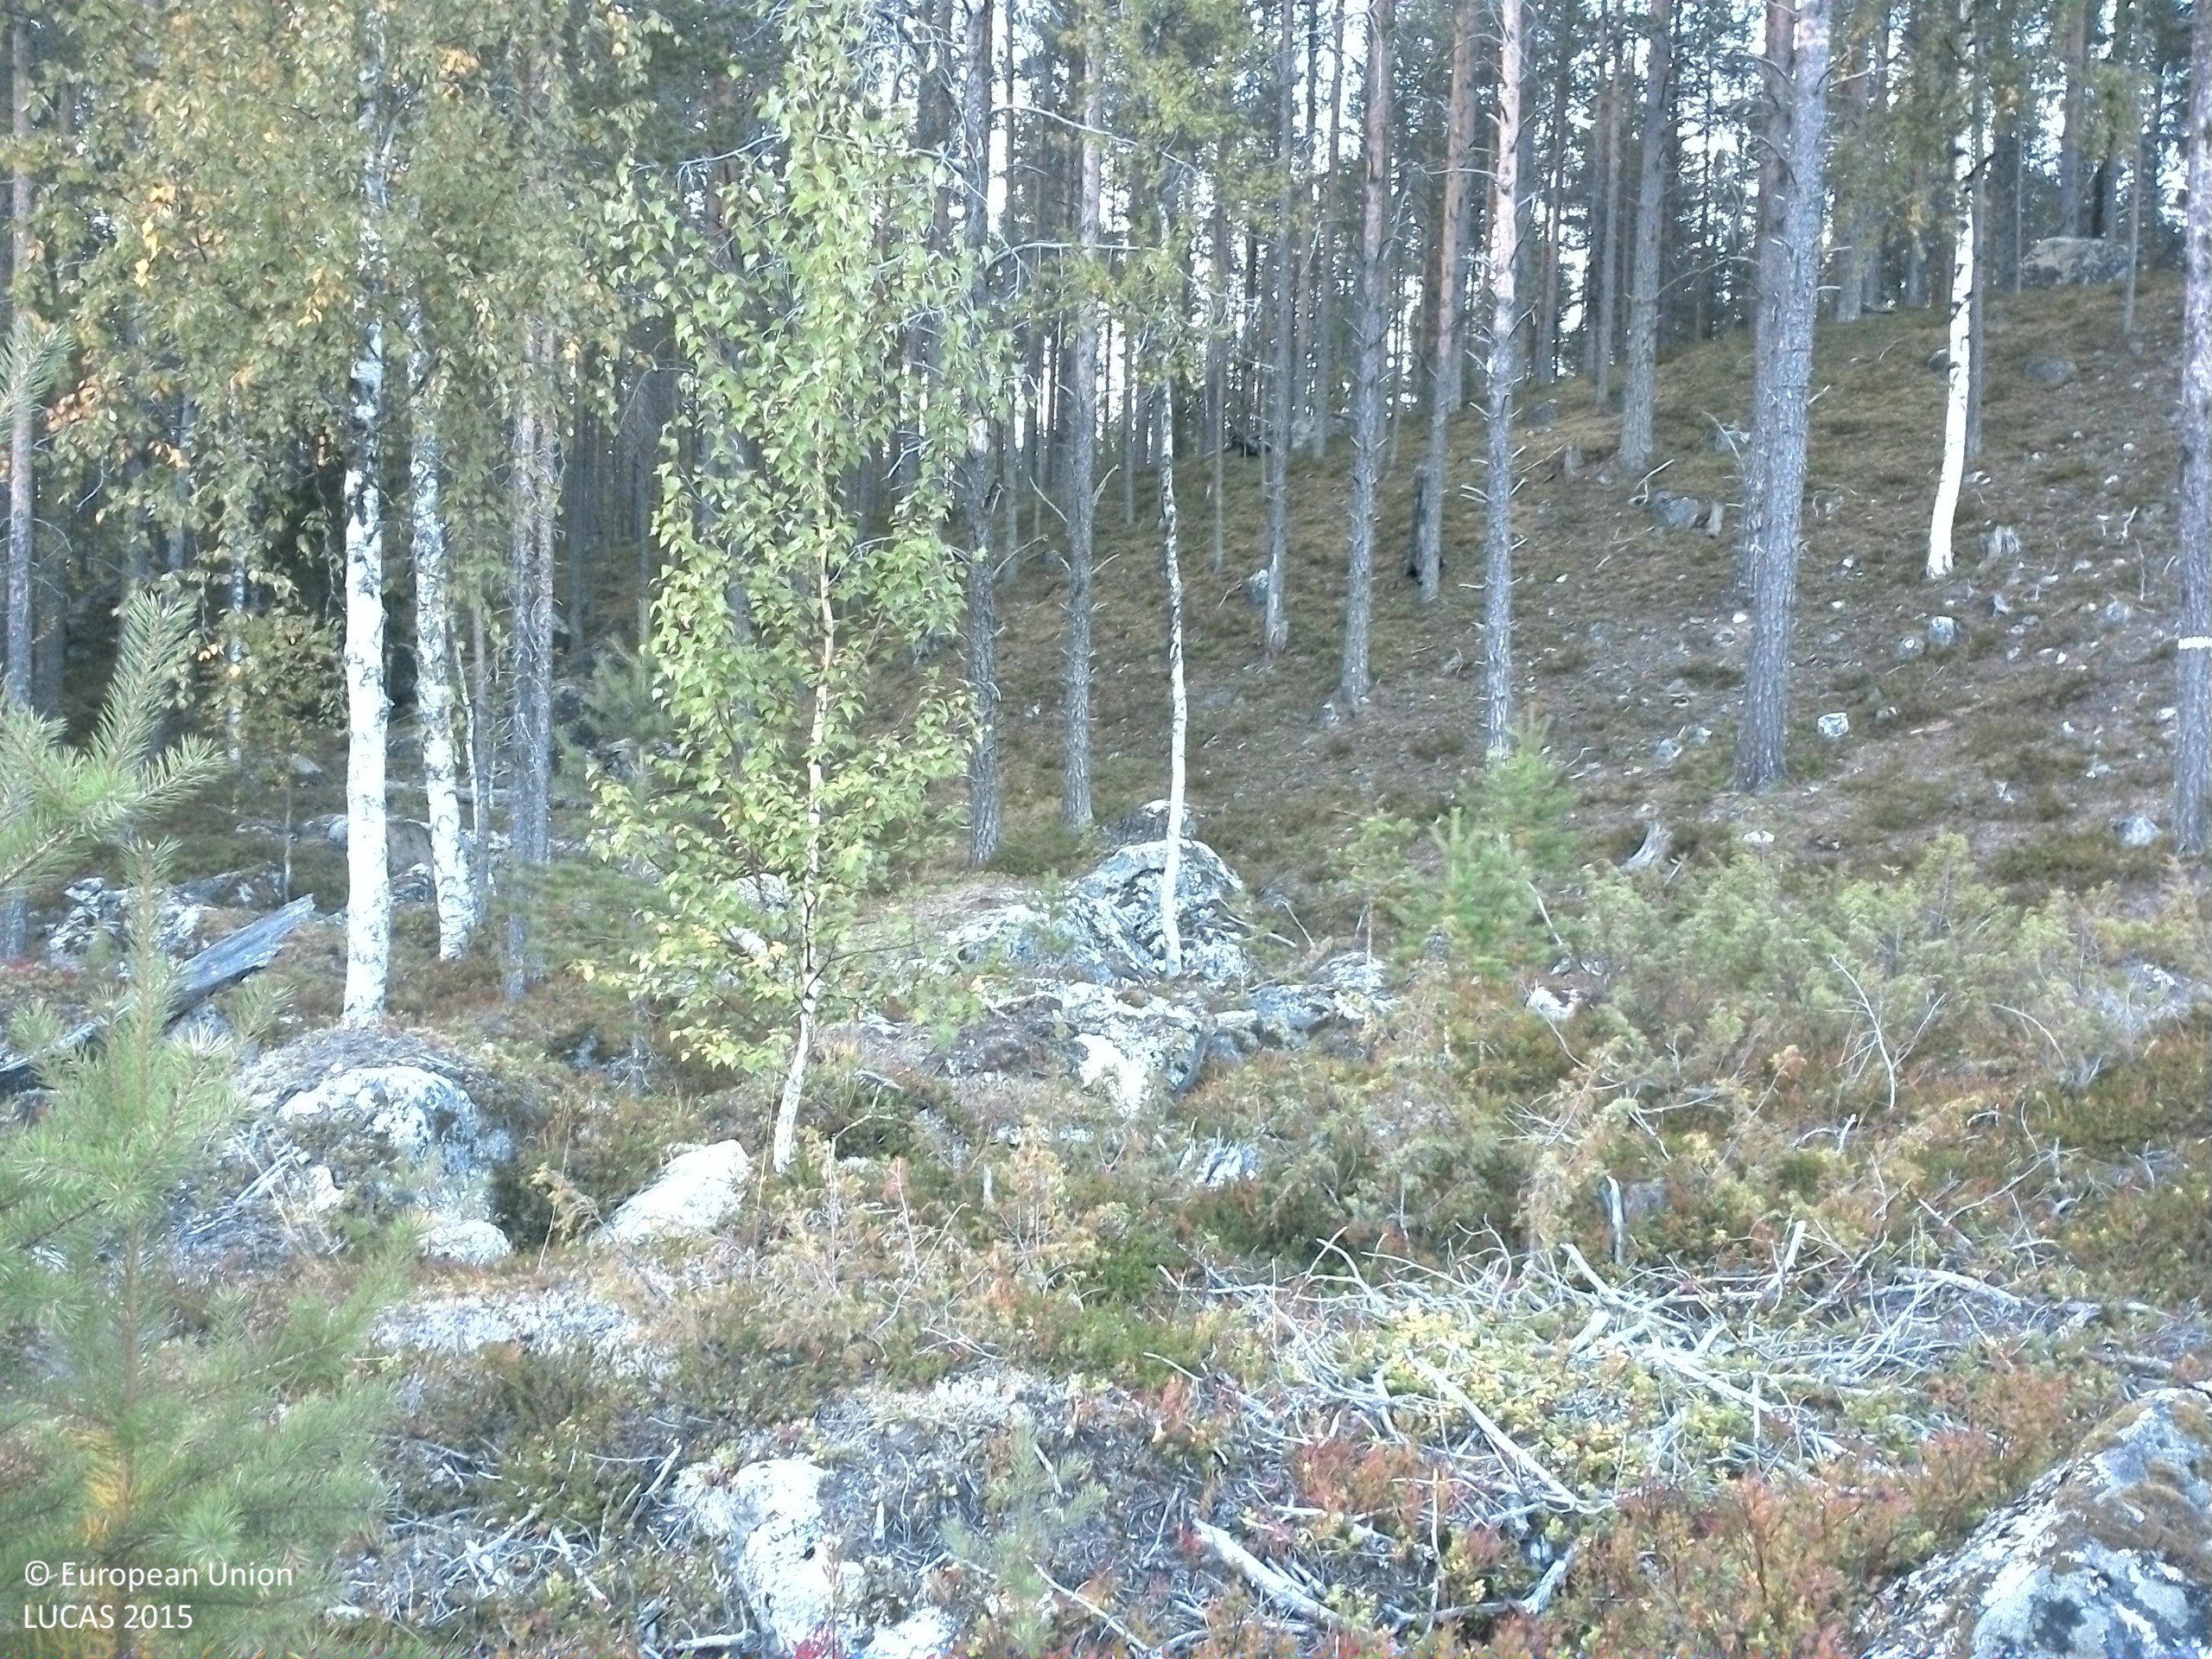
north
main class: Woodland
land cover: Pine dominated mixed woodland
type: boreal forest
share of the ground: 10 - 25 %
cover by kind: shrubs 45 %, lichens and mosses 25 %, coniferous forest trees 10 %, broadleaved forest trees 10 %, consolidated bare surface 10 %
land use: Forestry
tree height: < 5 m
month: September
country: SE
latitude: 63.9183
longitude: 16.5561
